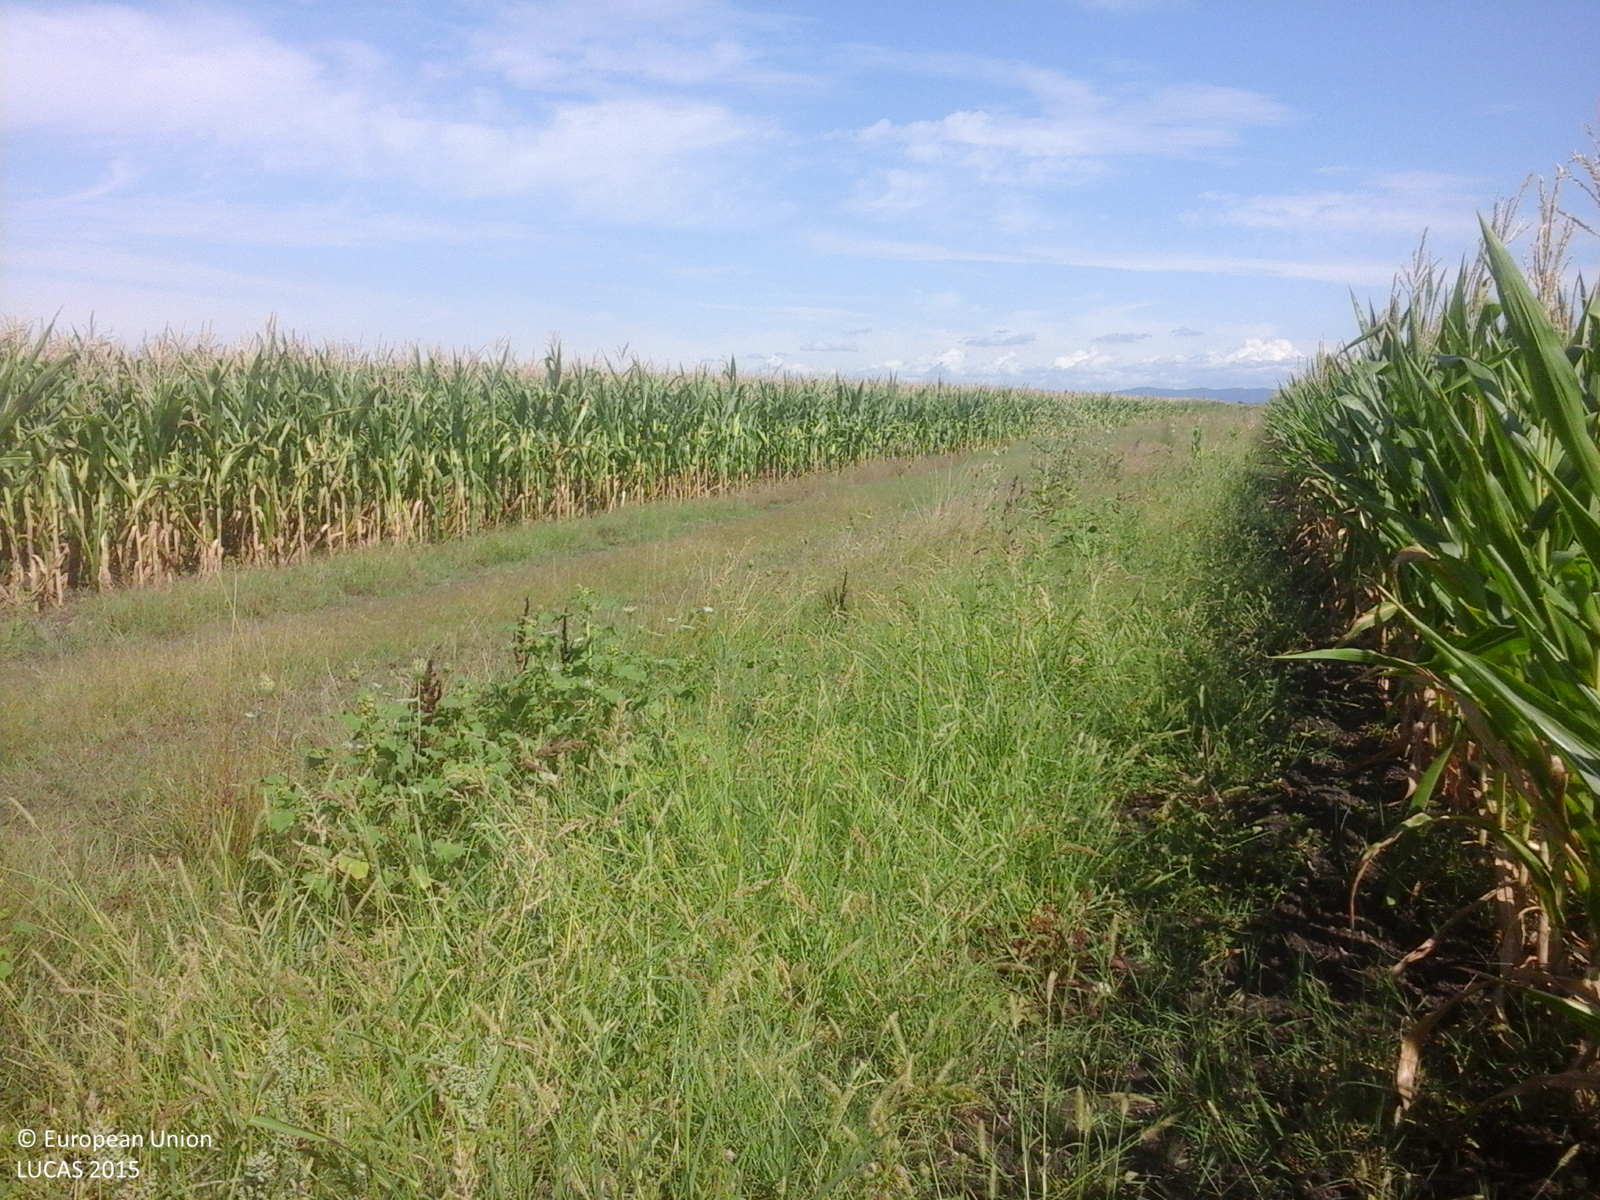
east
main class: Cropland
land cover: Maize
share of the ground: > 75 %
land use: Agriculture (excluding fallow land and kitchen gardens)
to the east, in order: Maize
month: August
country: RO
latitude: 45.3161
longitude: 21.4473
